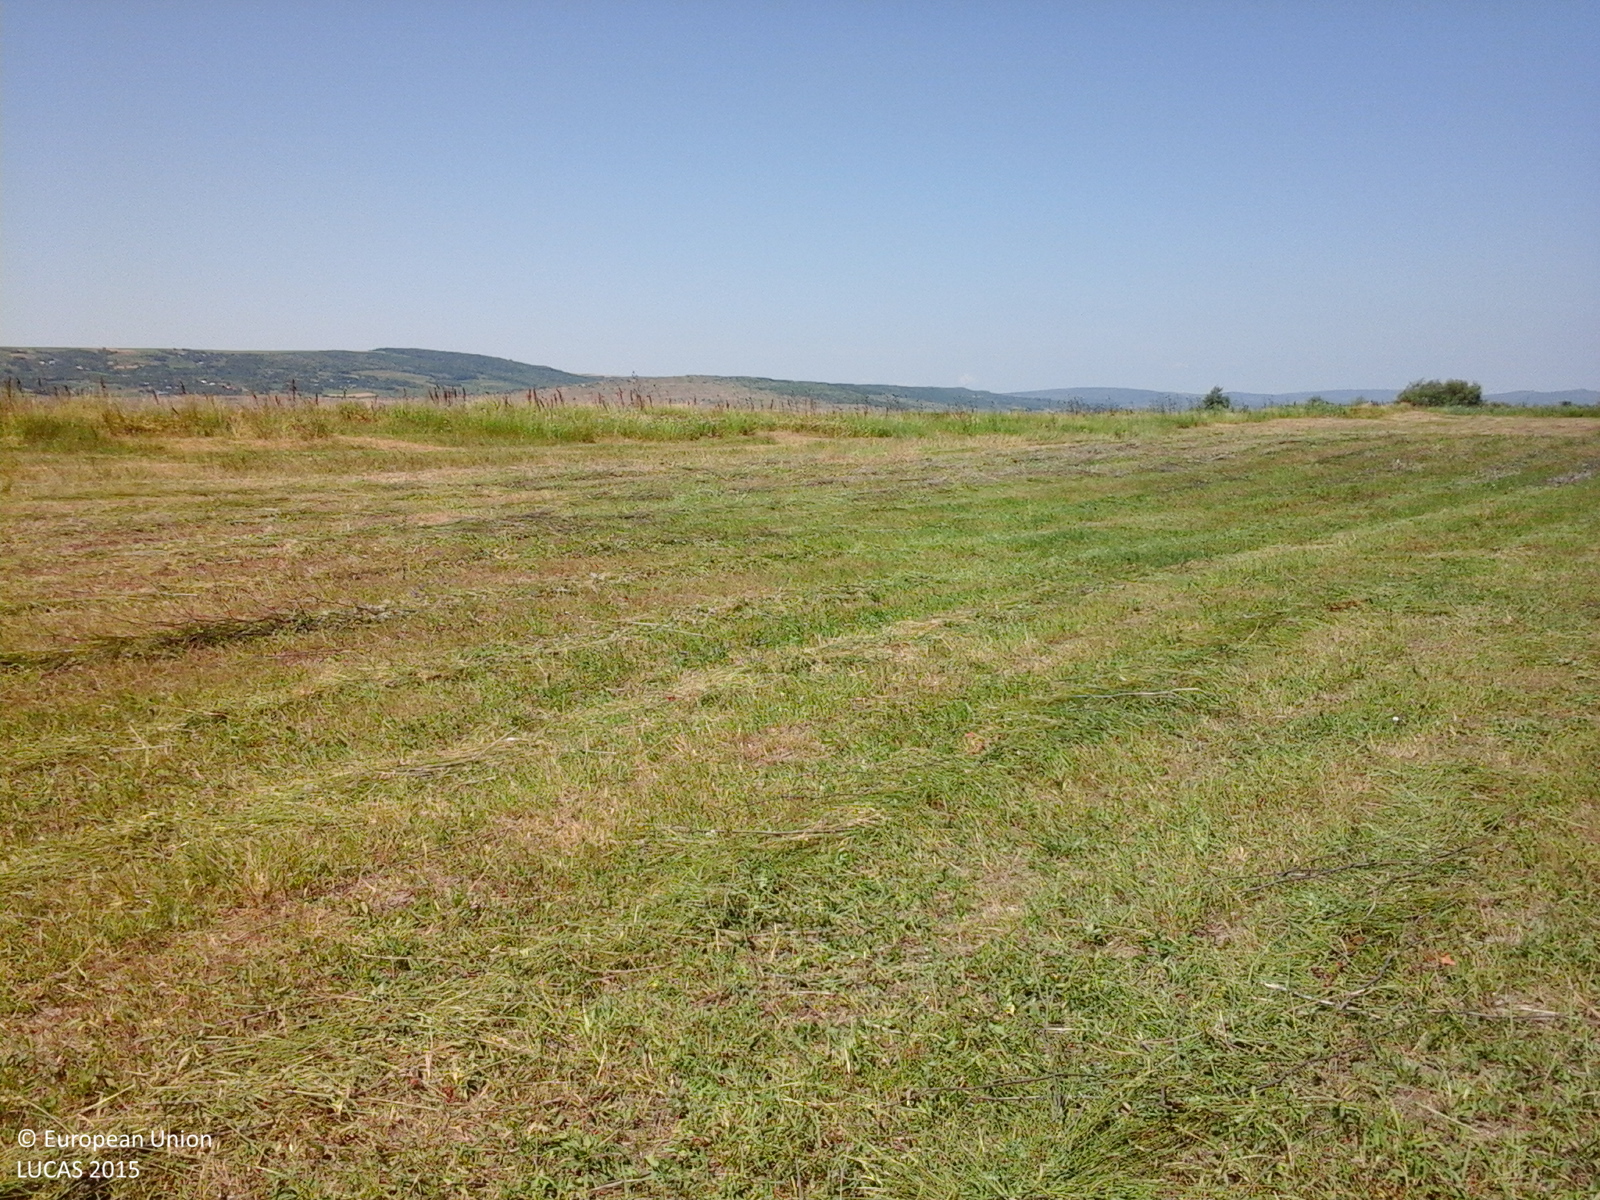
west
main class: Grassland
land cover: Grassland without tree/shrub cover
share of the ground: > 75 %
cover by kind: herbaceous plants 100 %
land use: Agriculture (excluding fallow land and kitchen gardens)
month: June
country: RO
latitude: 47.0012
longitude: 28.0034
